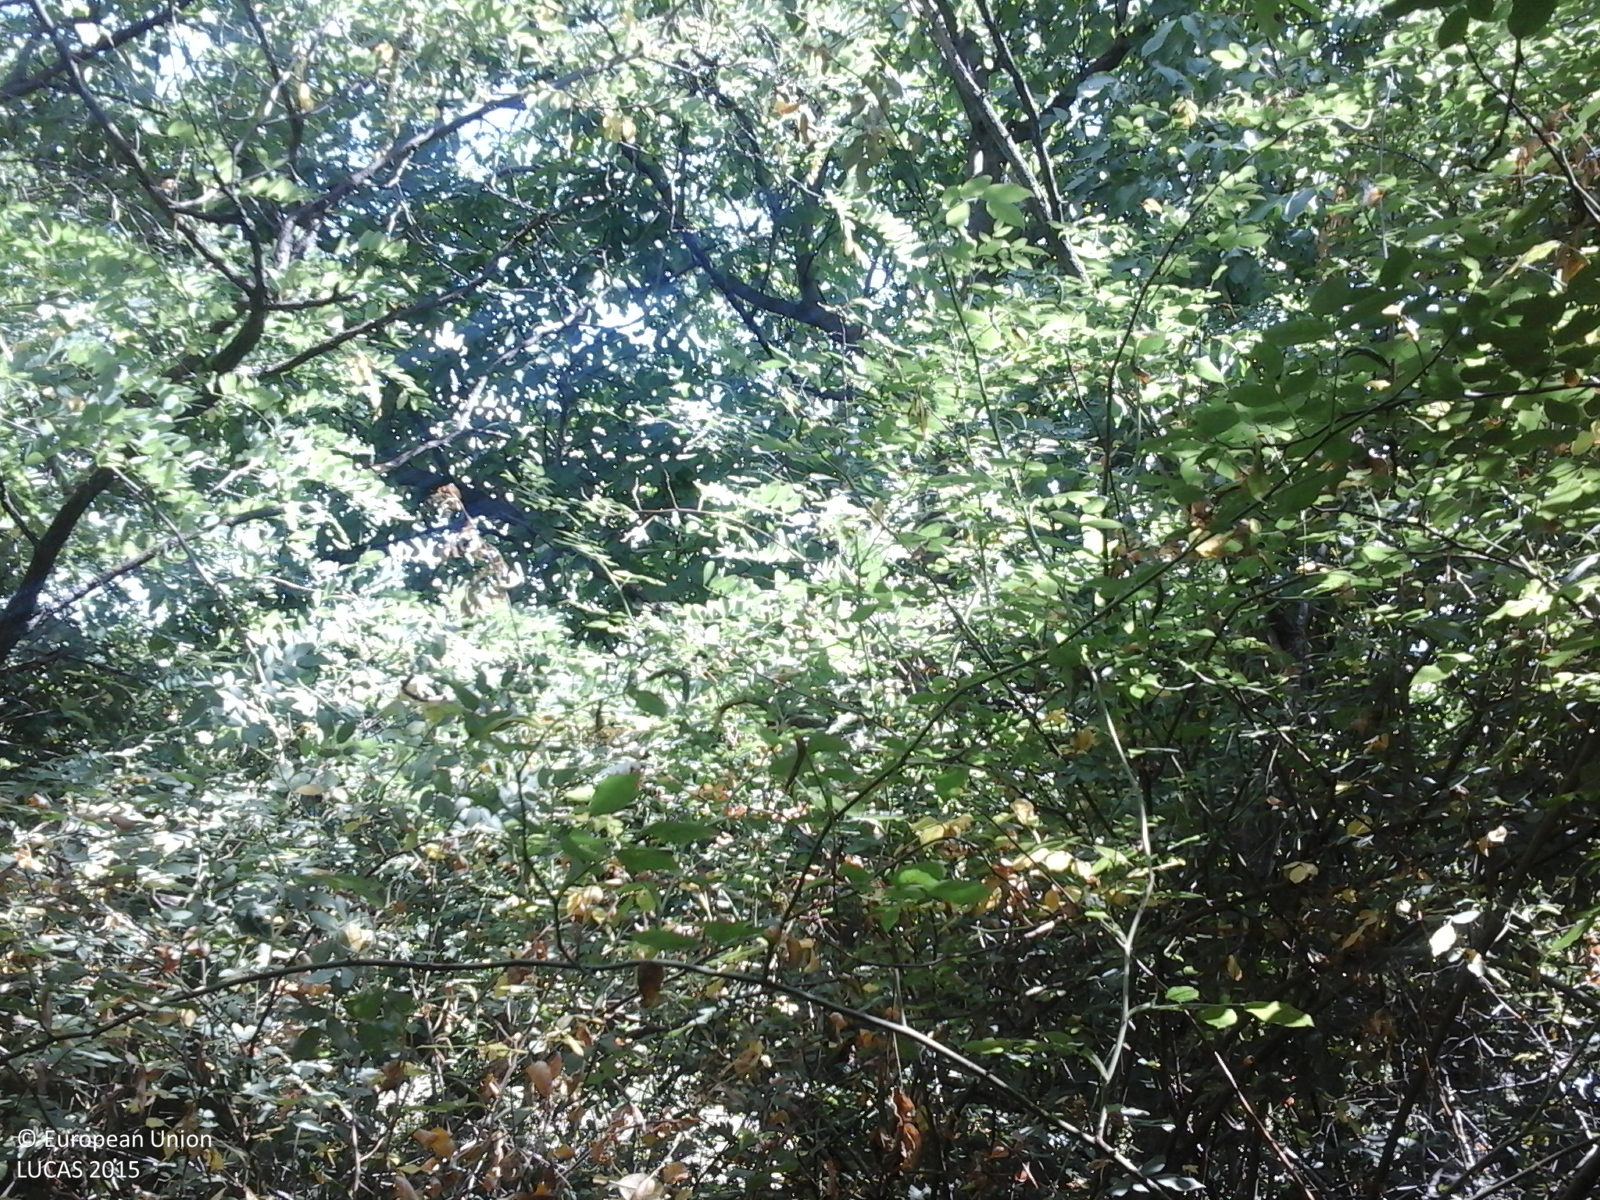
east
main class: Woodland
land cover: Broadleaved woodland
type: mesophytic deciduous forest
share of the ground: > 75 %
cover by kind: broadleaved forest trees 85 %, shrubs 10 %, herbaceous plants 5 %
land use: Forestry
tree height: > 5 m
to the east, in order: Broadleaved woodland; Tracks; Grass margins; Vineyards; Grass margins; Tracks; Grass margins; Vineyards
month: July
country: RO
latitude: 46.2737
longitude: 27.6179
